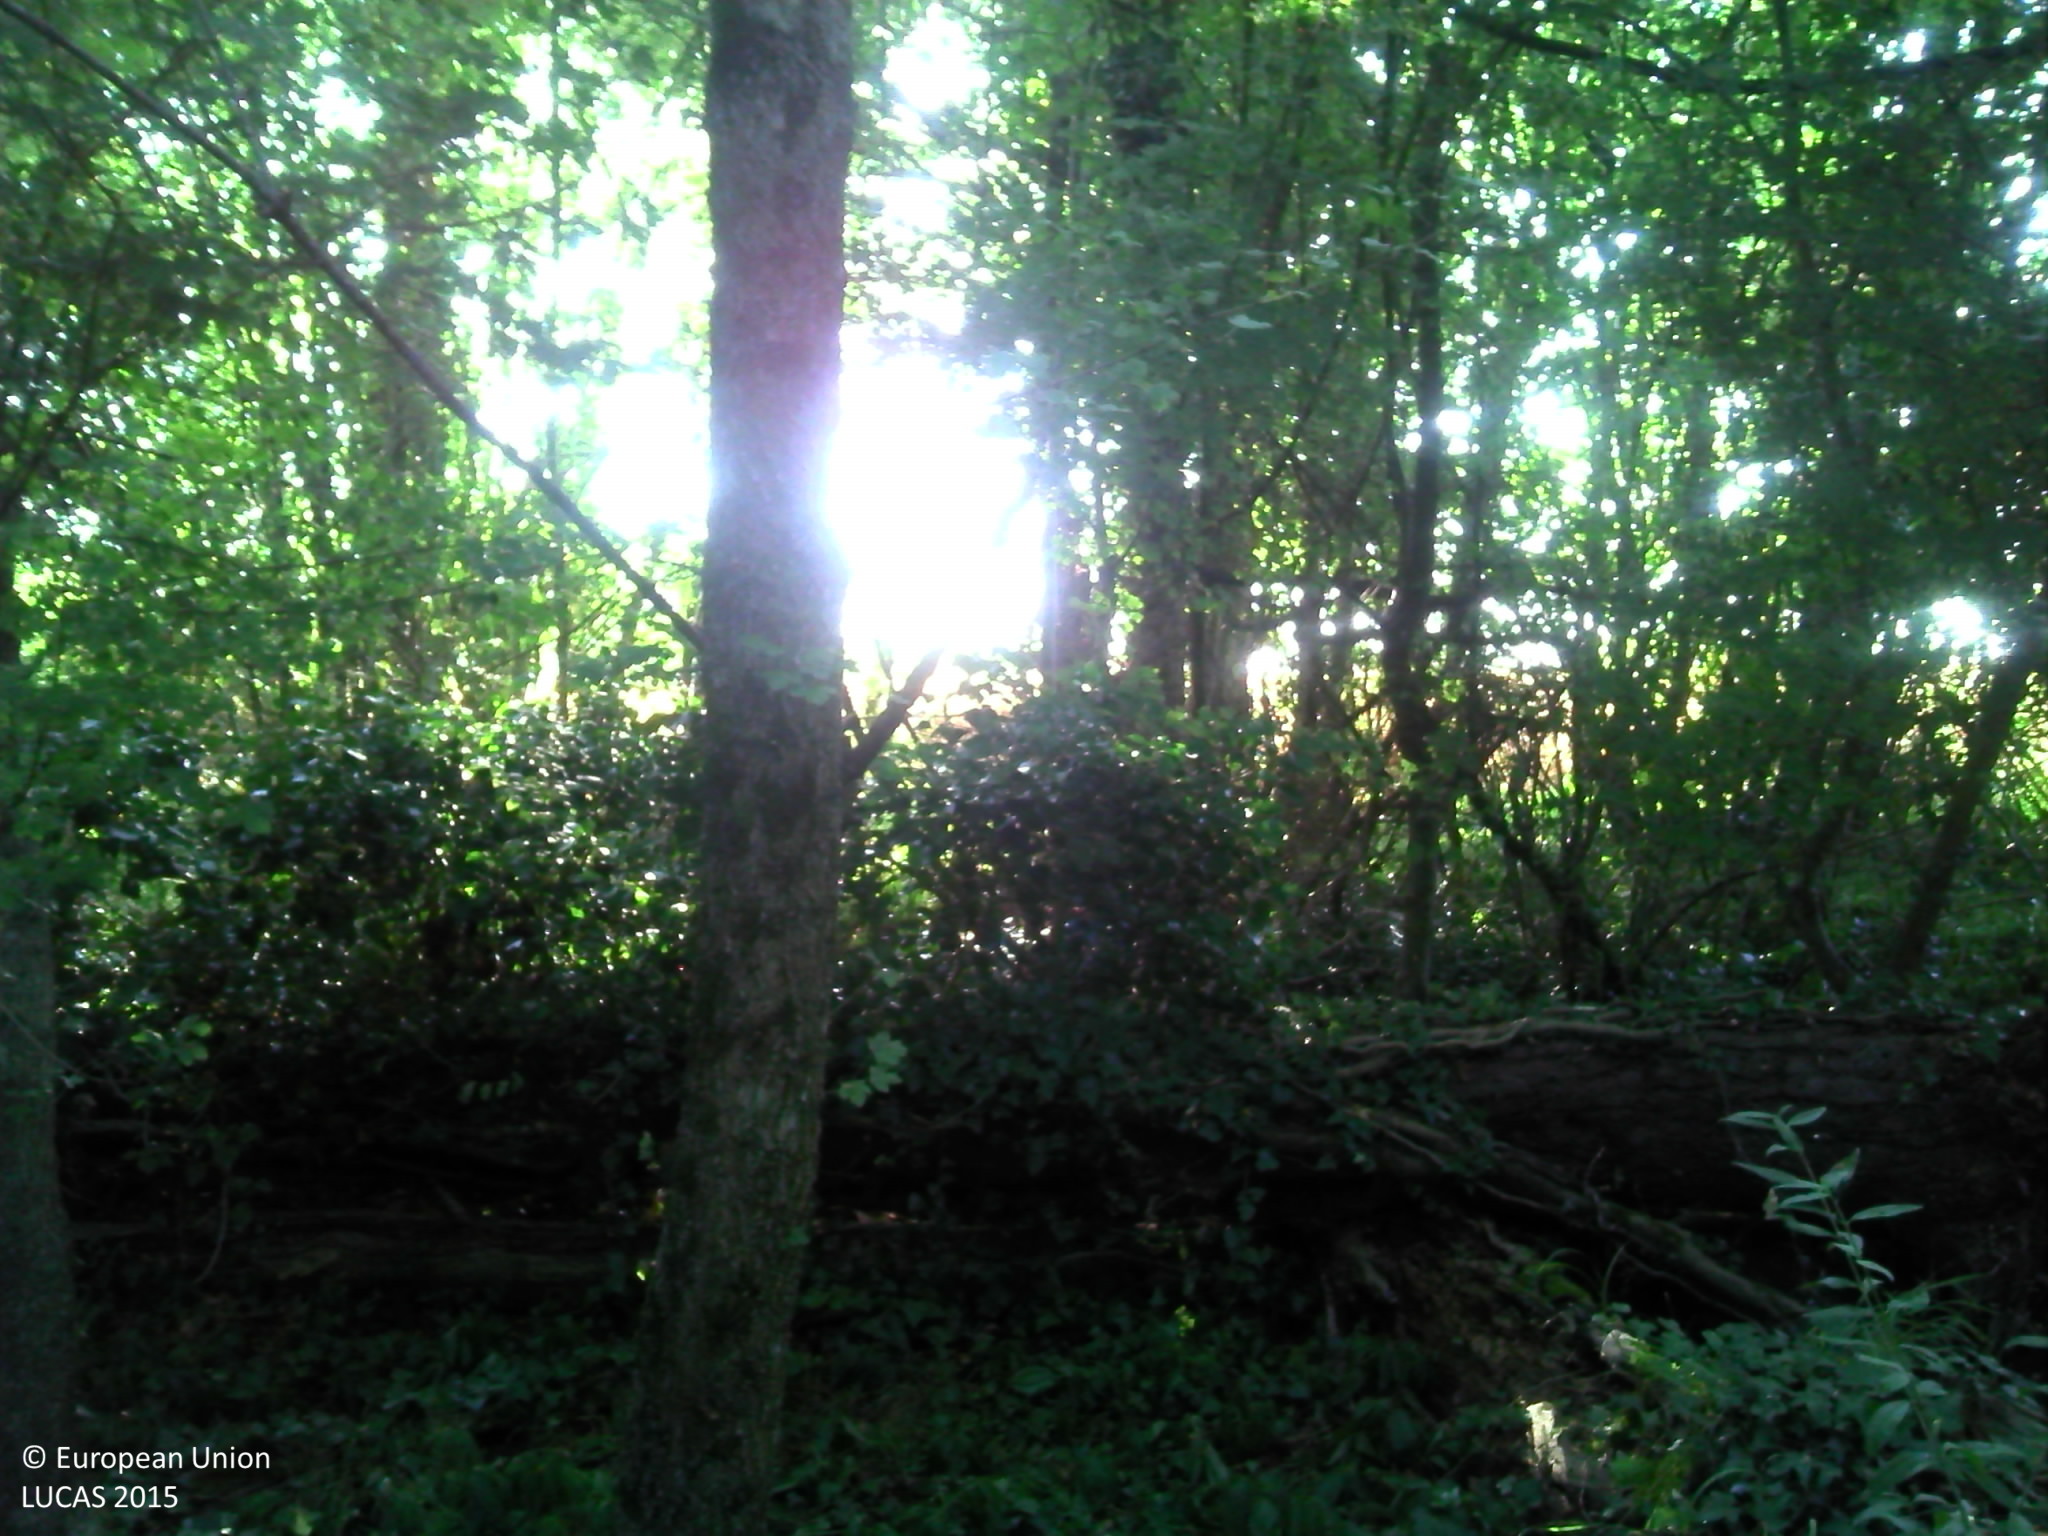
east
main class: Woodland
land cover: Broadleaved woodland
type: mesophytic deciduous forest
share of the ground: > 75 %
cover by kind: broadleaved forest trees 100 %
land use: Semi-natural and natural areas not in use
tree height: > 5 m
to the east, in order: Broadleaved woodland; Common wheat
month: July
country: FR
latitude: 46.8439
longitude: 3.2701
